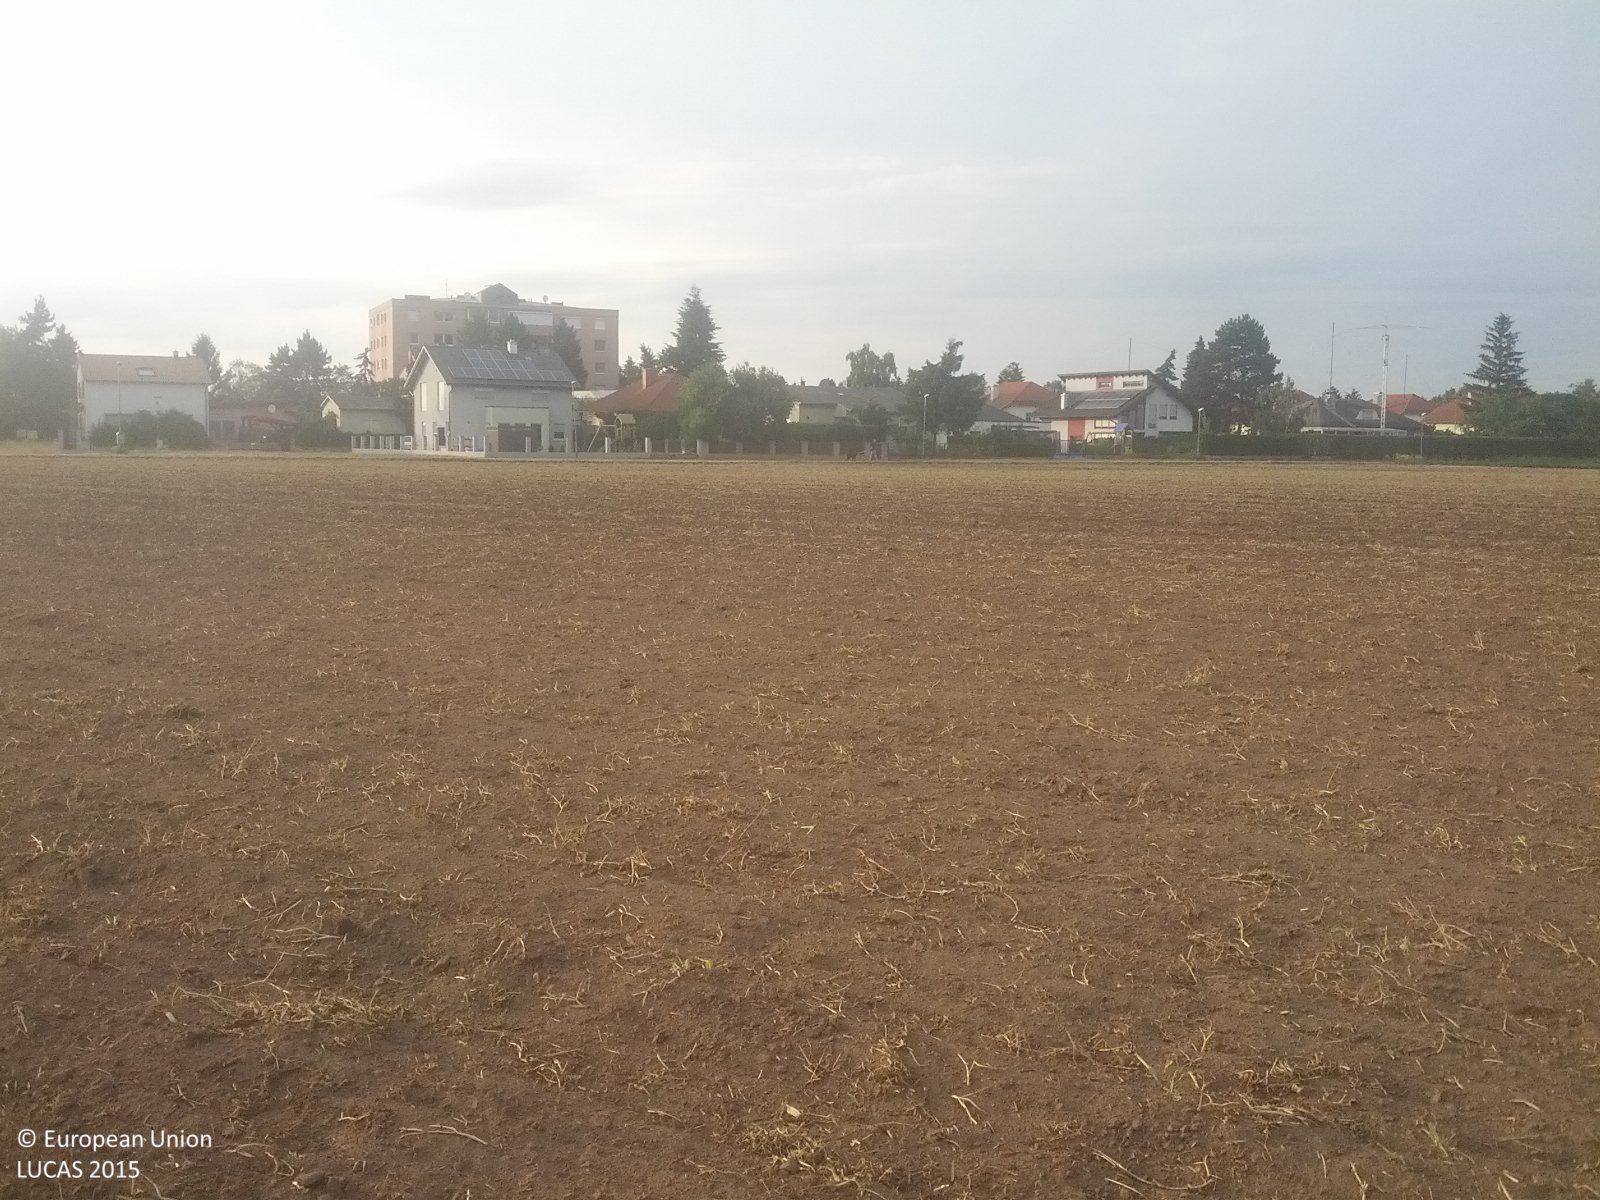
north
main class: Cropland
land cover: Dry pulses
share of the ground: < 10 %
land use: Agriculture (excluding fallow land and kitchen gardens)
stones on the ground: 10 - 25 %
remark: Harvested field
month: June
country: AT
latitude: 48.2983
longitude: 16.5708
